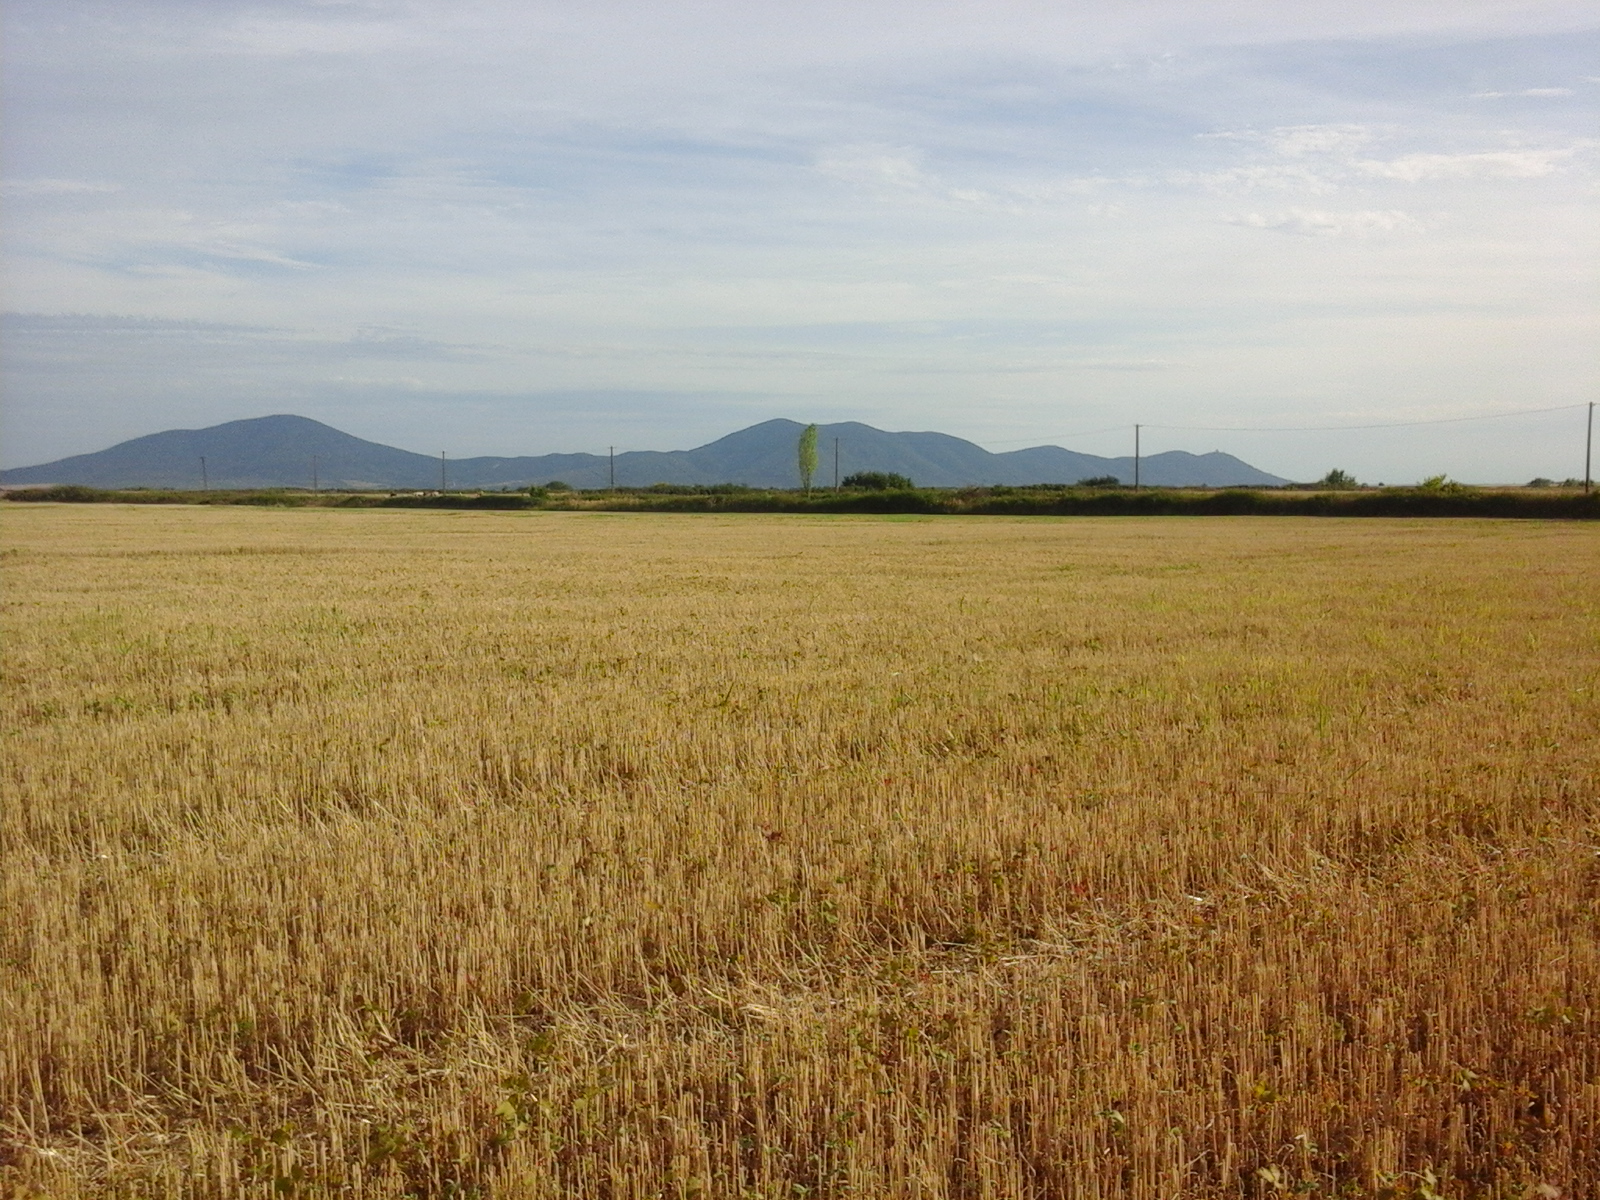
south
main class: Cropland
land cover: Common wheat
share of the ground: > 75 %
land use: Agriculture (excluding fallow land and kitchen gardens)
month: August
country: RO
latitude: 45.2327
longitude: 21.3784
